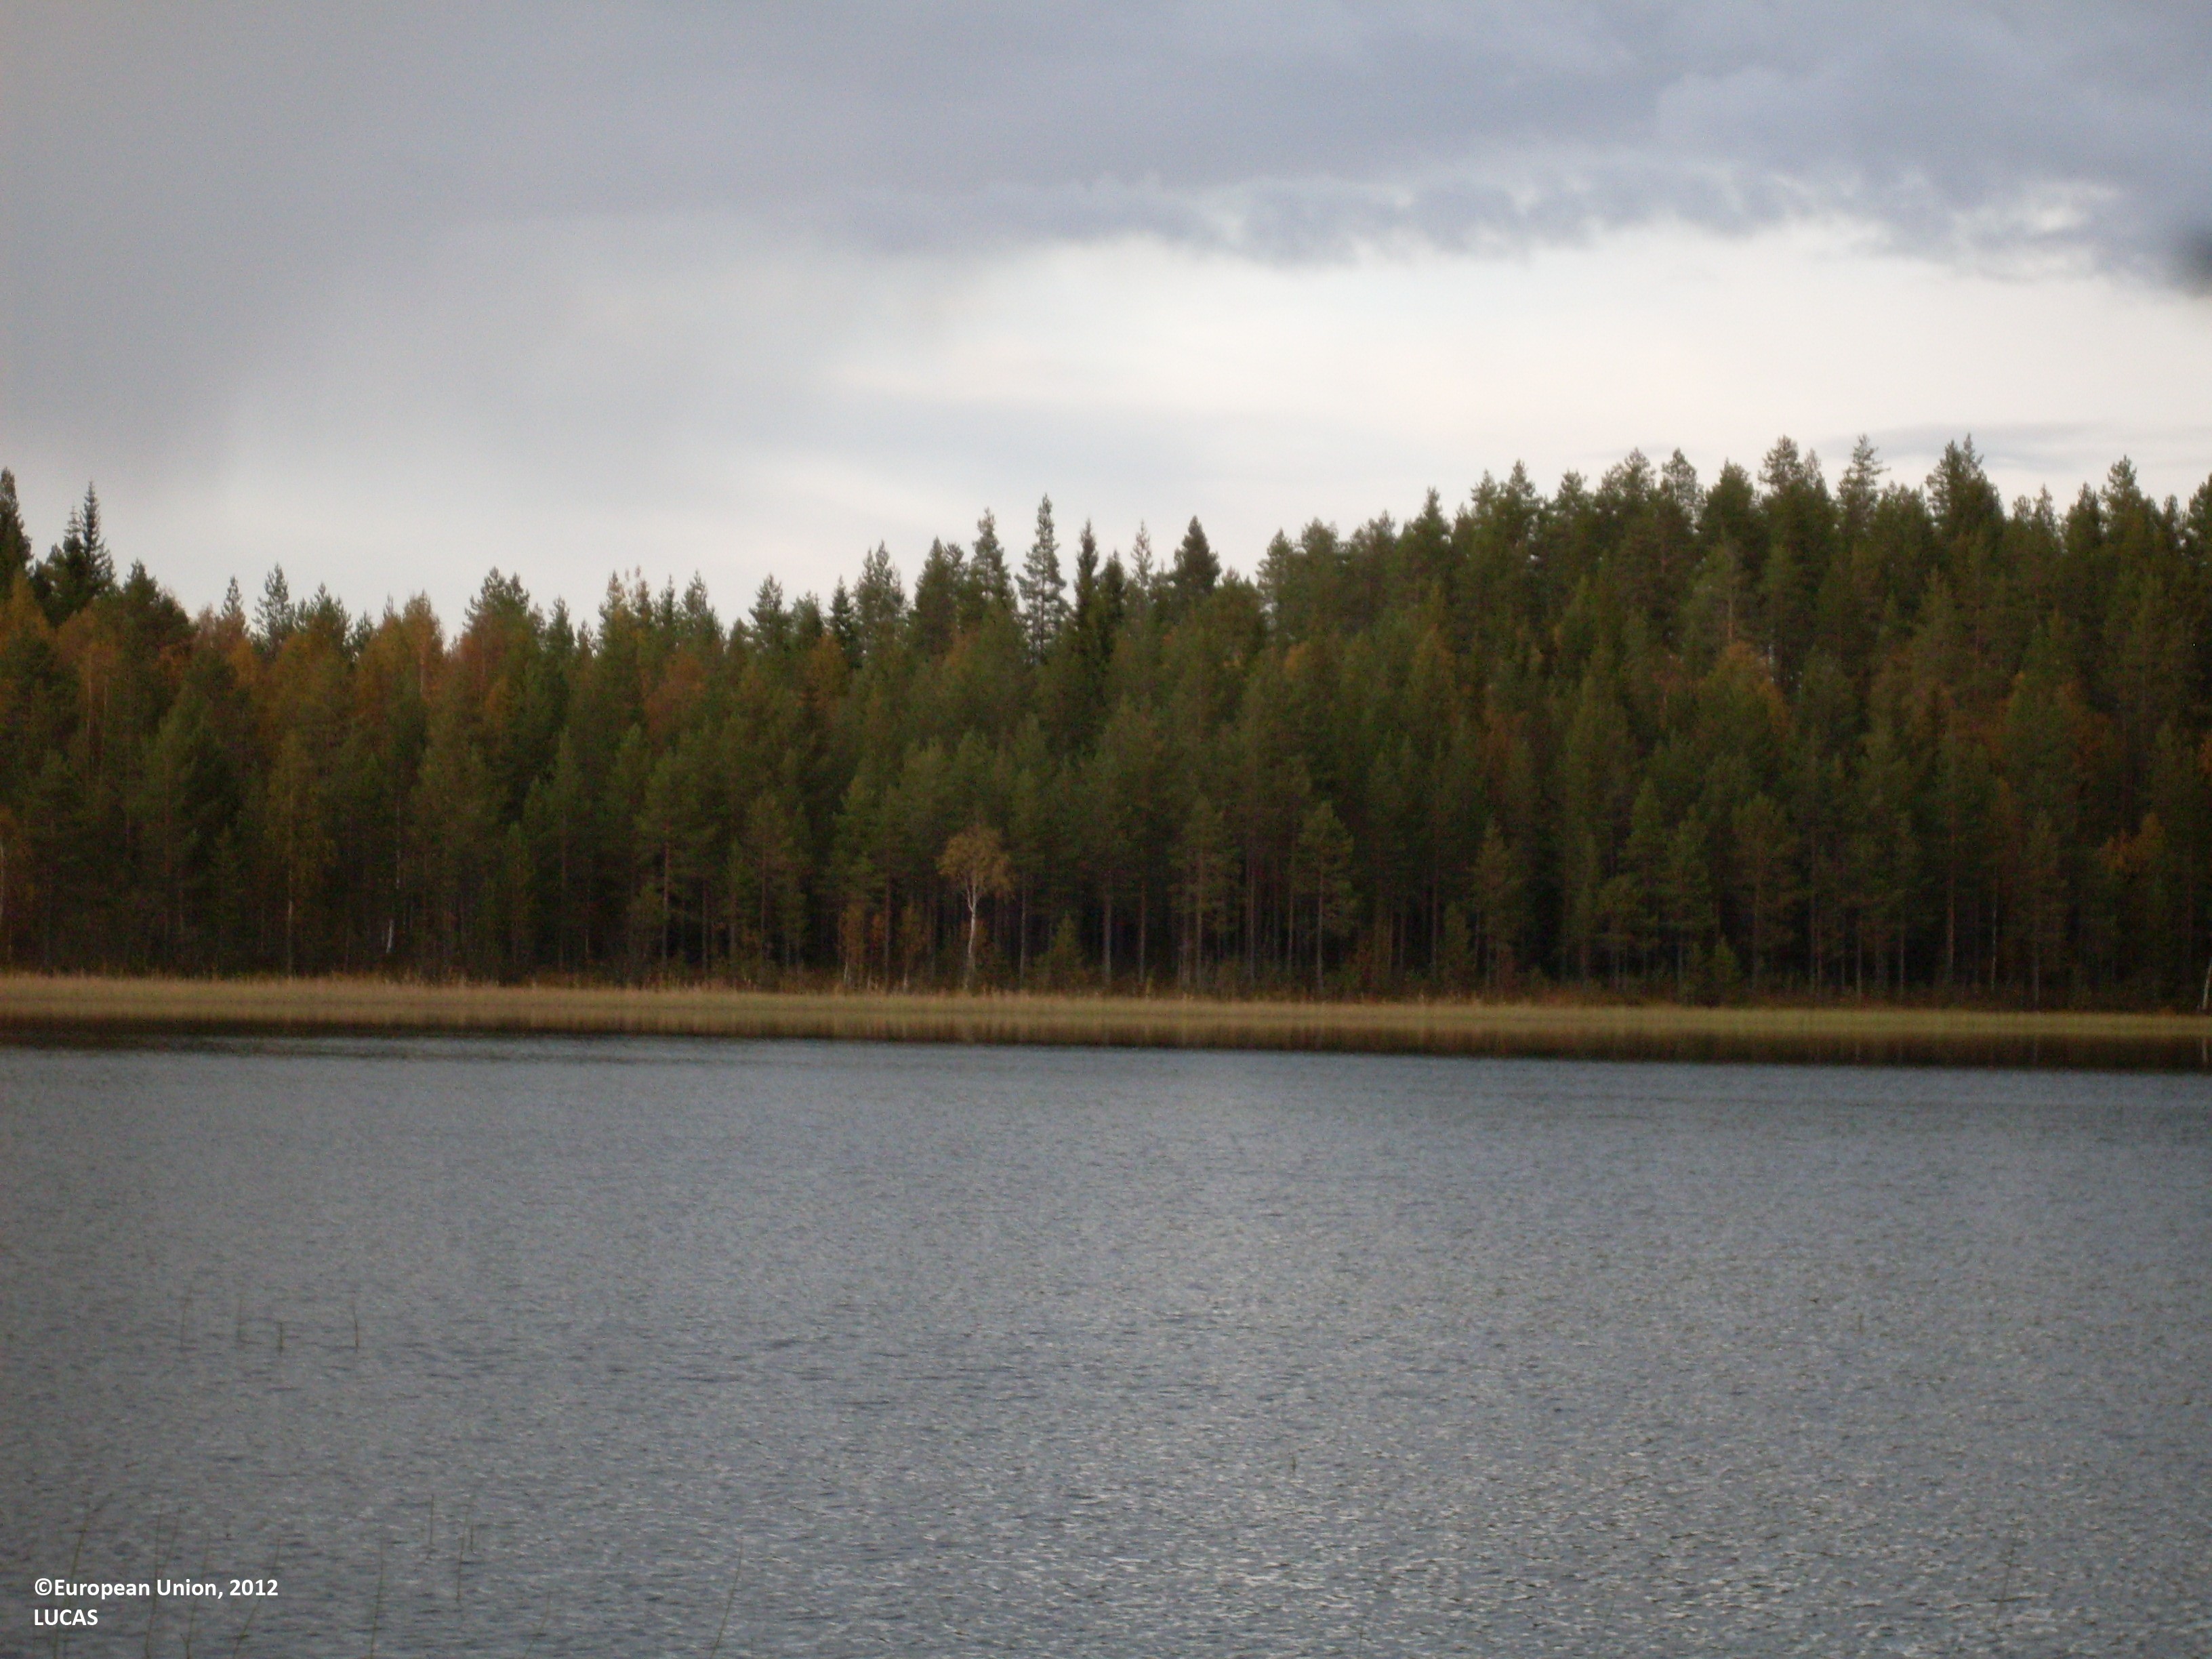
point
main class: Woodland
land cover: Pine dominated mixed woodland
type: boreal forest
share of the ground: 10 - 25 %
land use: Forestry
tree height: > 5 m
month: September
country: FI
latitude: 64.0355
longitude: 30.0384
